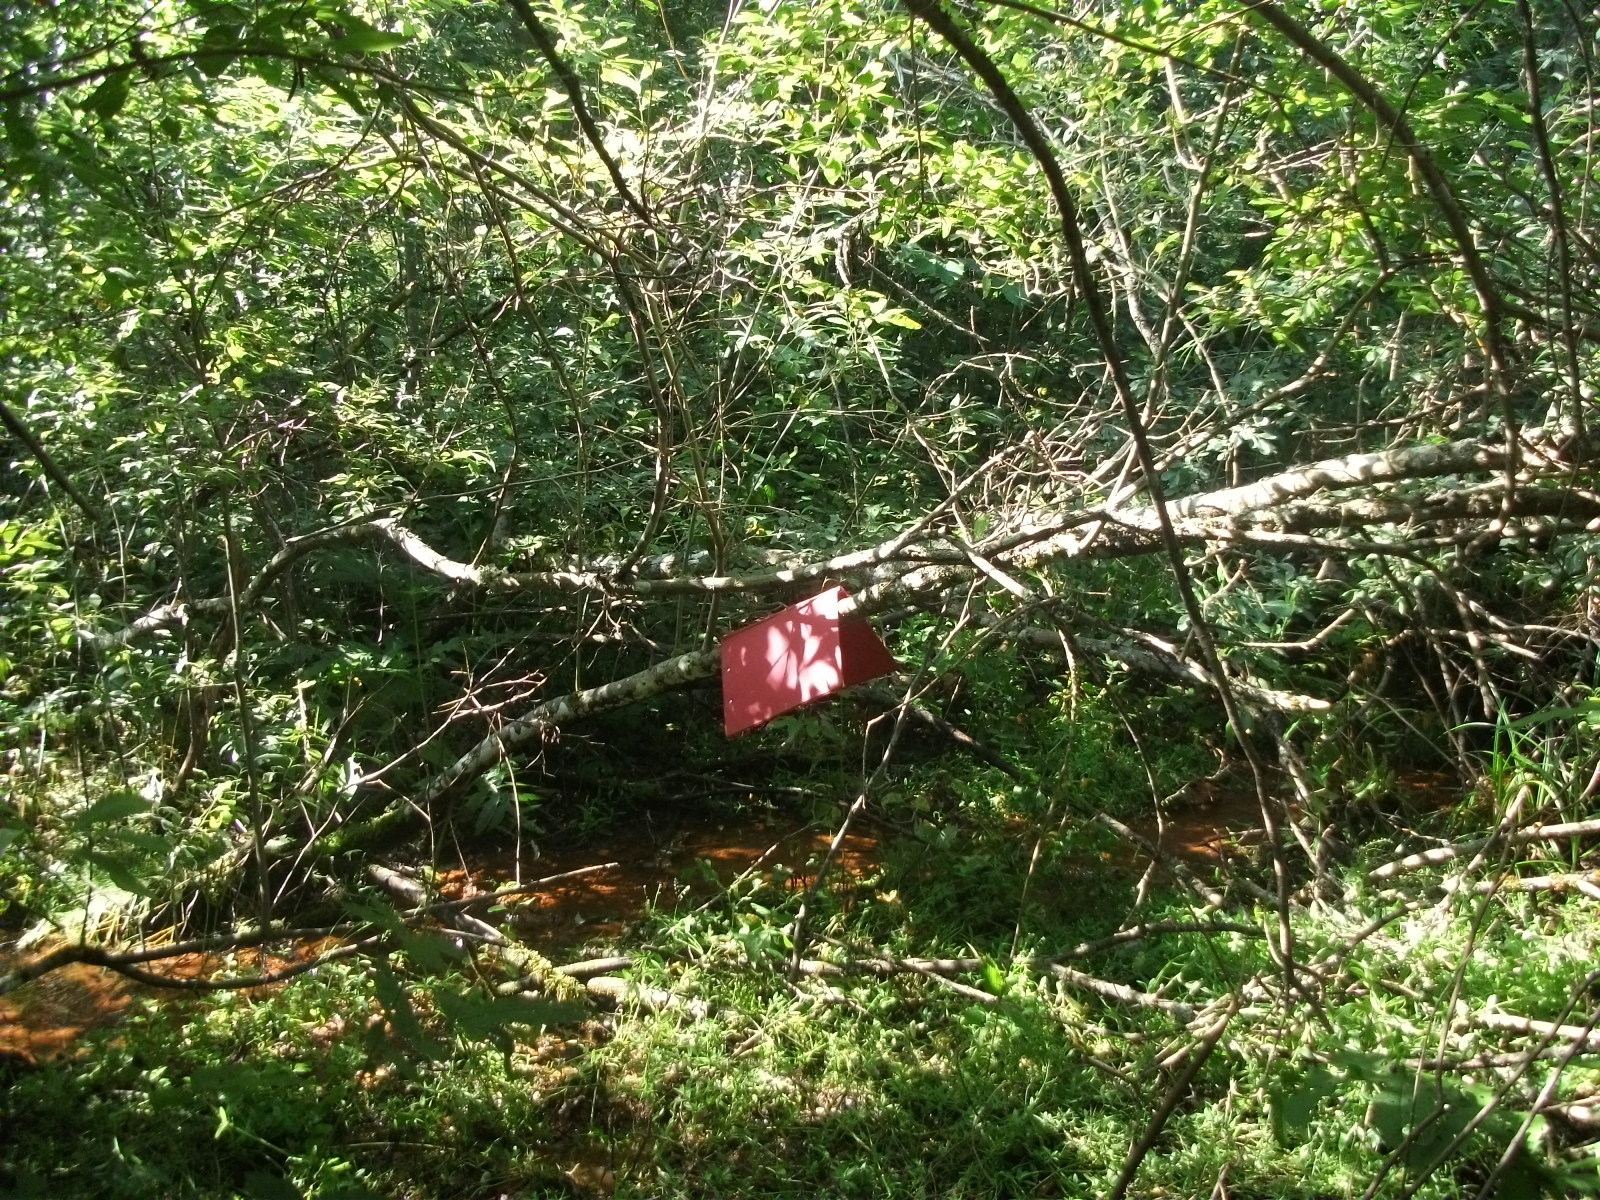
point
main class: Woodland
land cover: Broadleaved woodland
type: floodplain forest
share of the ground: > 75 %
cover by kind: broadleaved forest trees 80 %, shrubs 15 %, herbaceous plants 5 %
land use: Semi-natural and natural areas not in use
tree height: < 5 m
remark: Temporary flooded
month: August
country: LV
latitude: 56.9260
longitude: 26.3919
